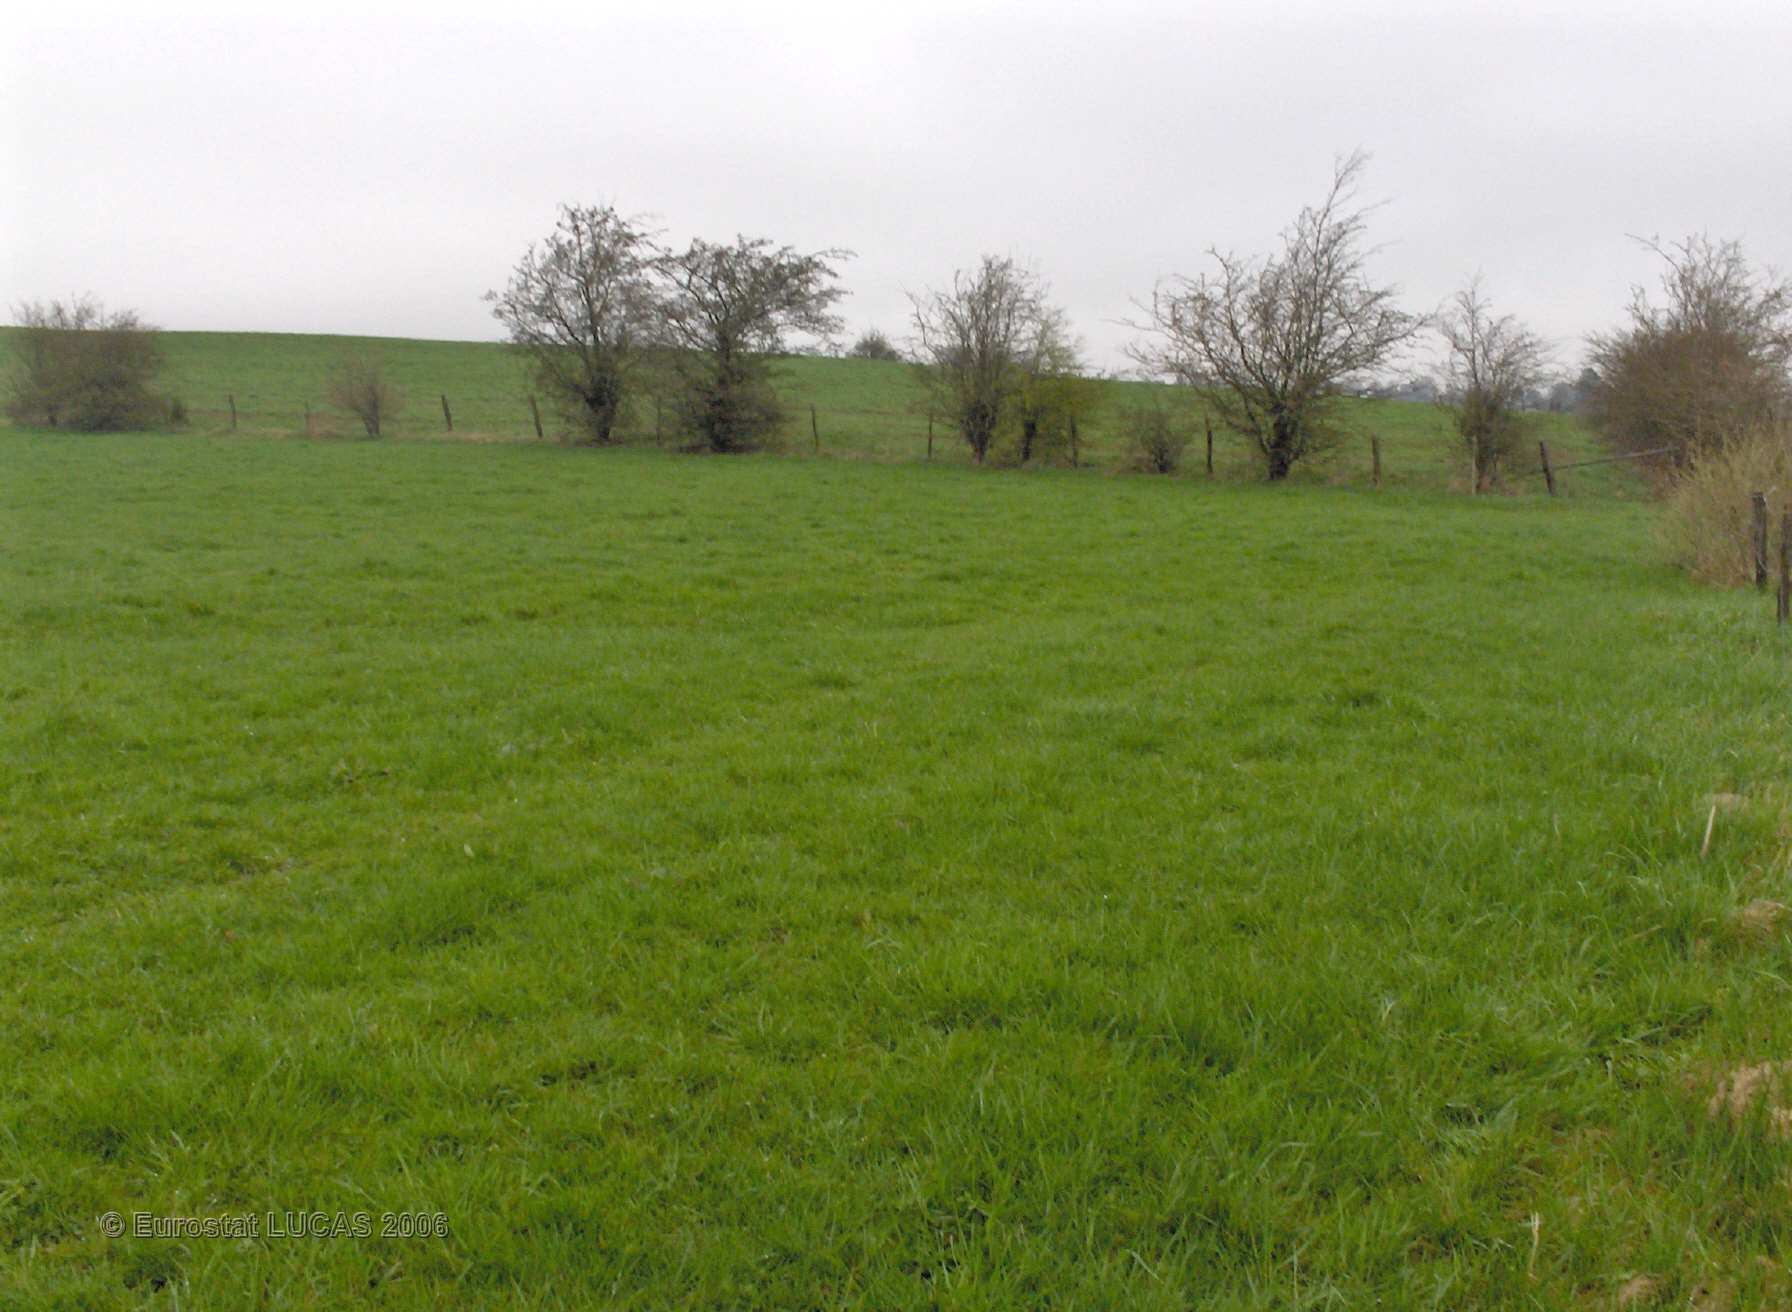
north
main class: Grassland
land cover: Grassland without tree/shrub cover
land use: Agriculture (excluding fallow land and kitchen gardens)
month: May
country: BE
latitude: 50.3233
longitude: 6.3335
